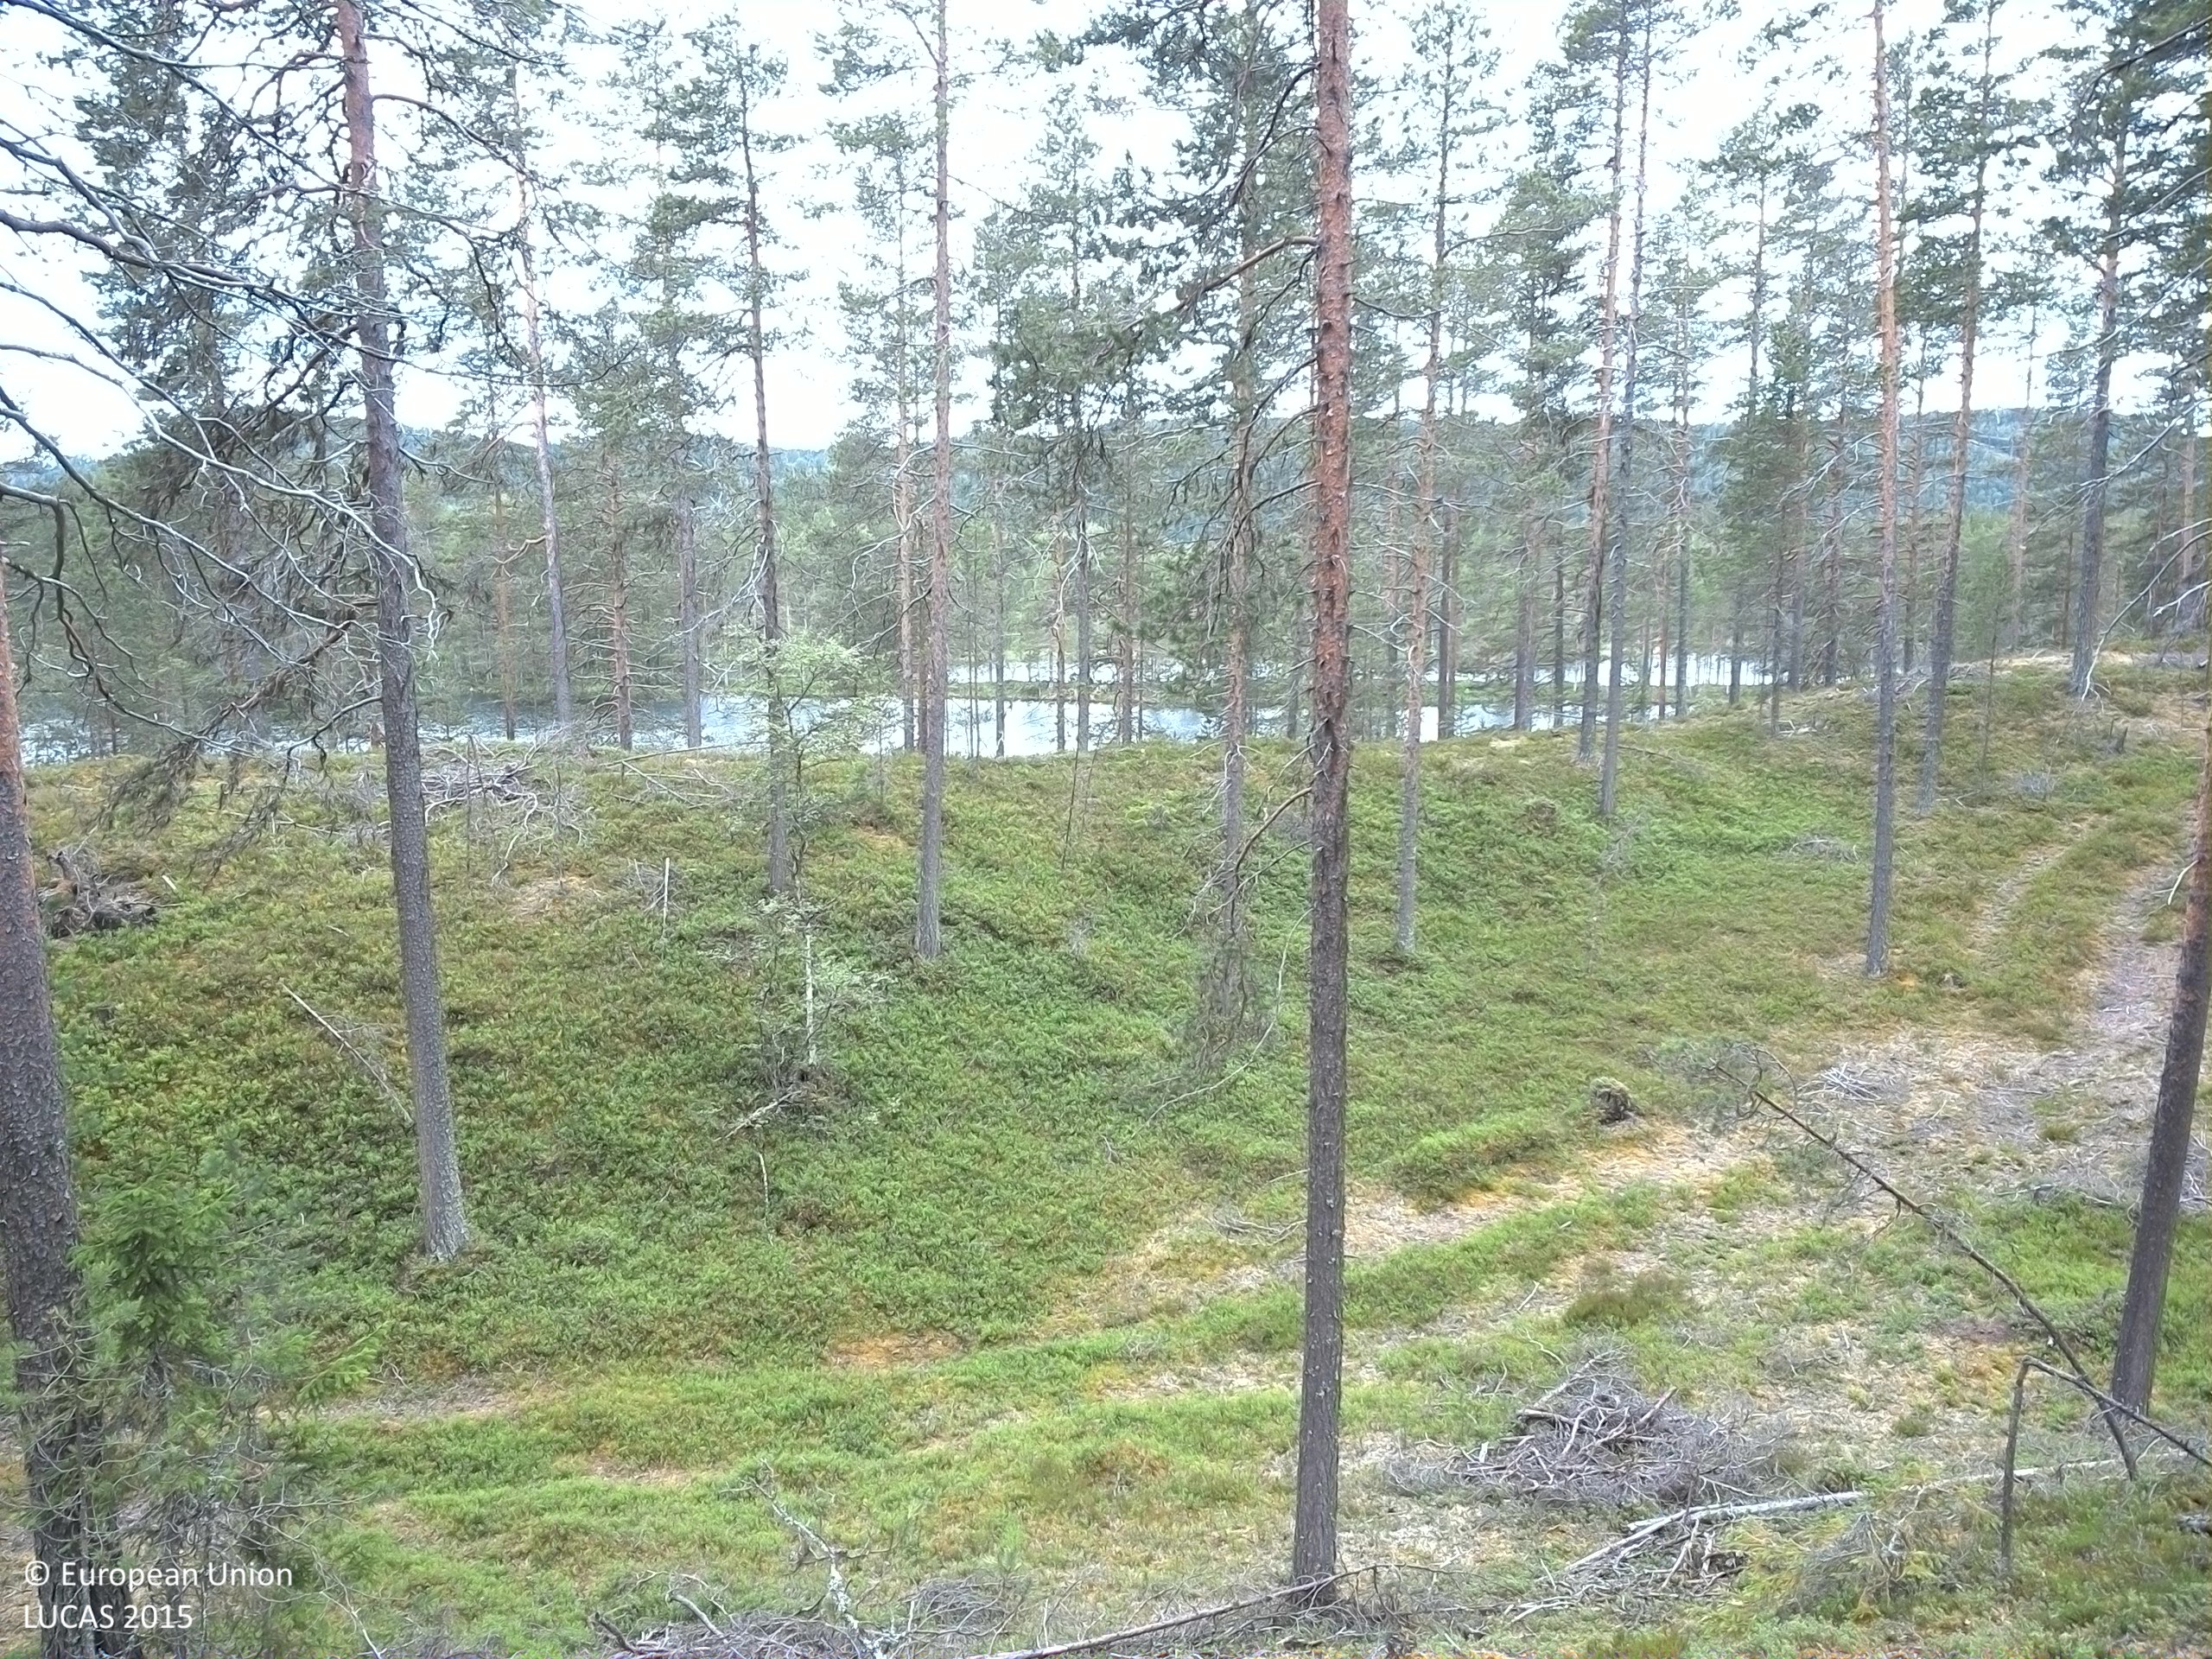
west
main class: Woodland
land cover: Pine dominated coniferous woodland
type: boreal forest
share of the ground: 25 - 50 %
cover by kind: shrubs 50 %, coniferous forest trees 25 %, lichens and mosses 25 %
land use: Forestry
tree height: > 5 m
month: August
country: SE
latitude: 63.6891
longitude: 17.2321
